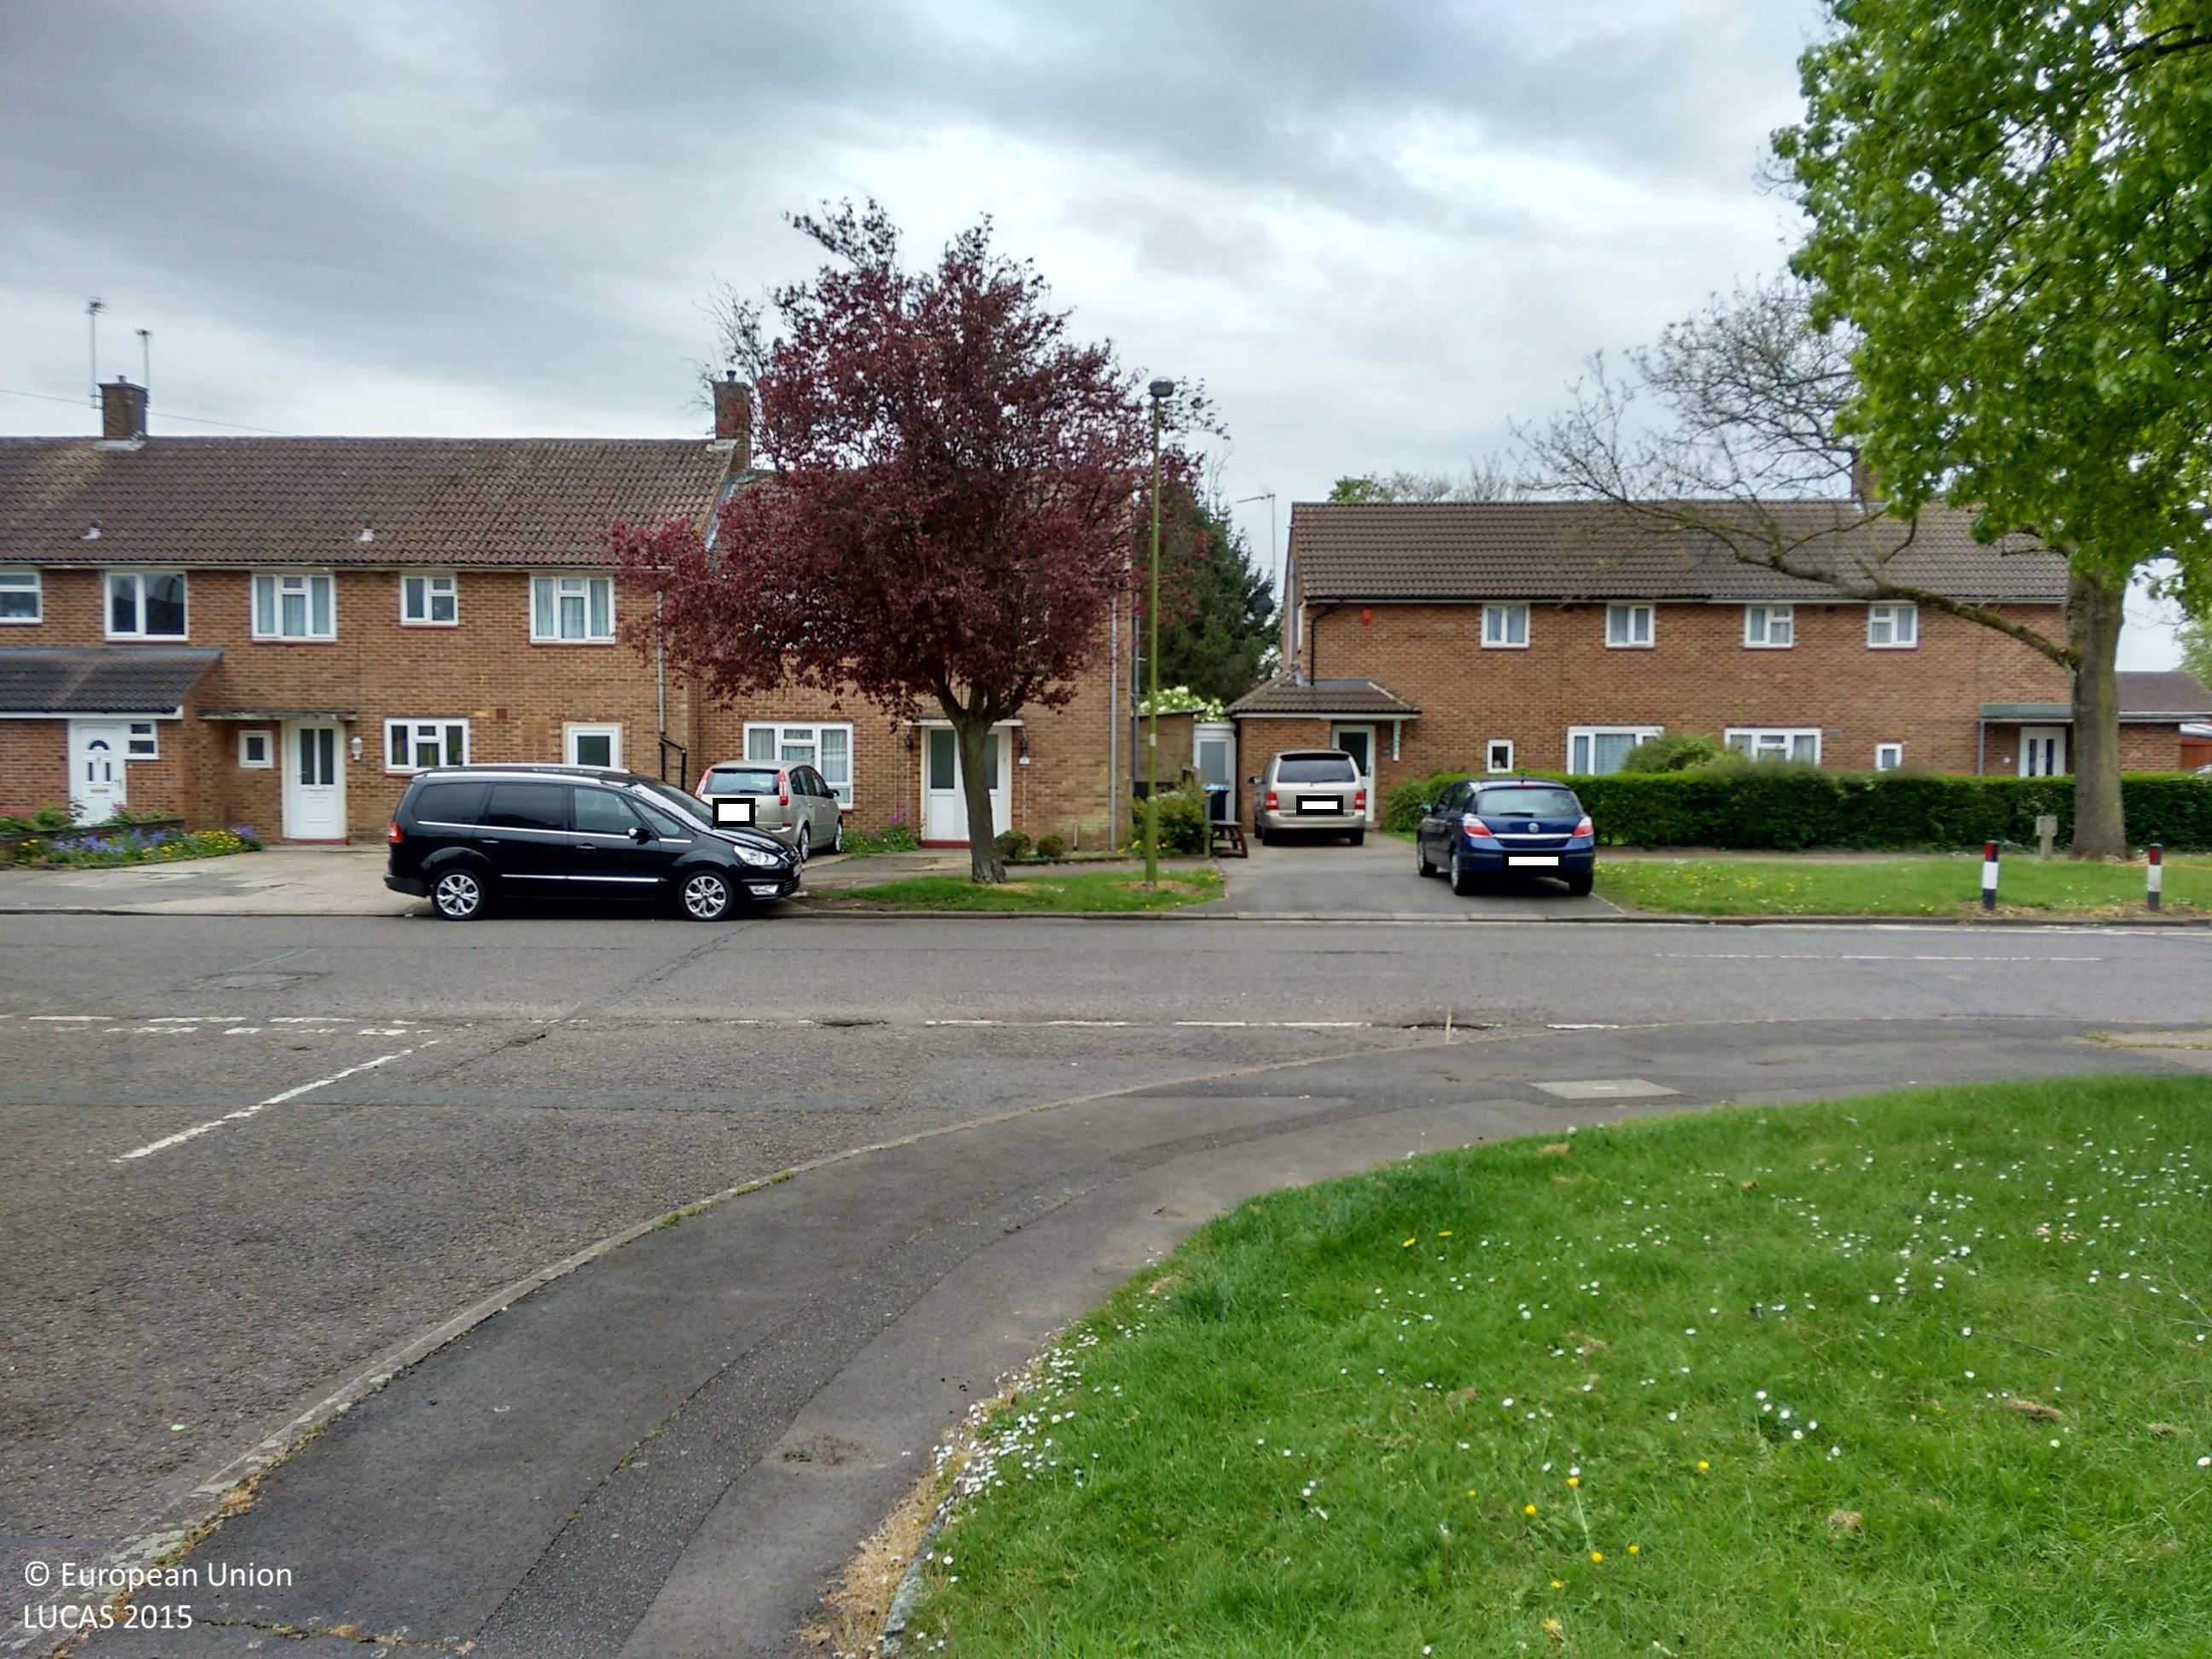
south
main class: Grassland
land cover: Grassland without tree/shrub cover
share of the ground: > 75 %
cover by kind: herbaceous plants 100 %
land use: Residential
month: May
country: GB
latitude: 51.7515
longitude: -0.4529
